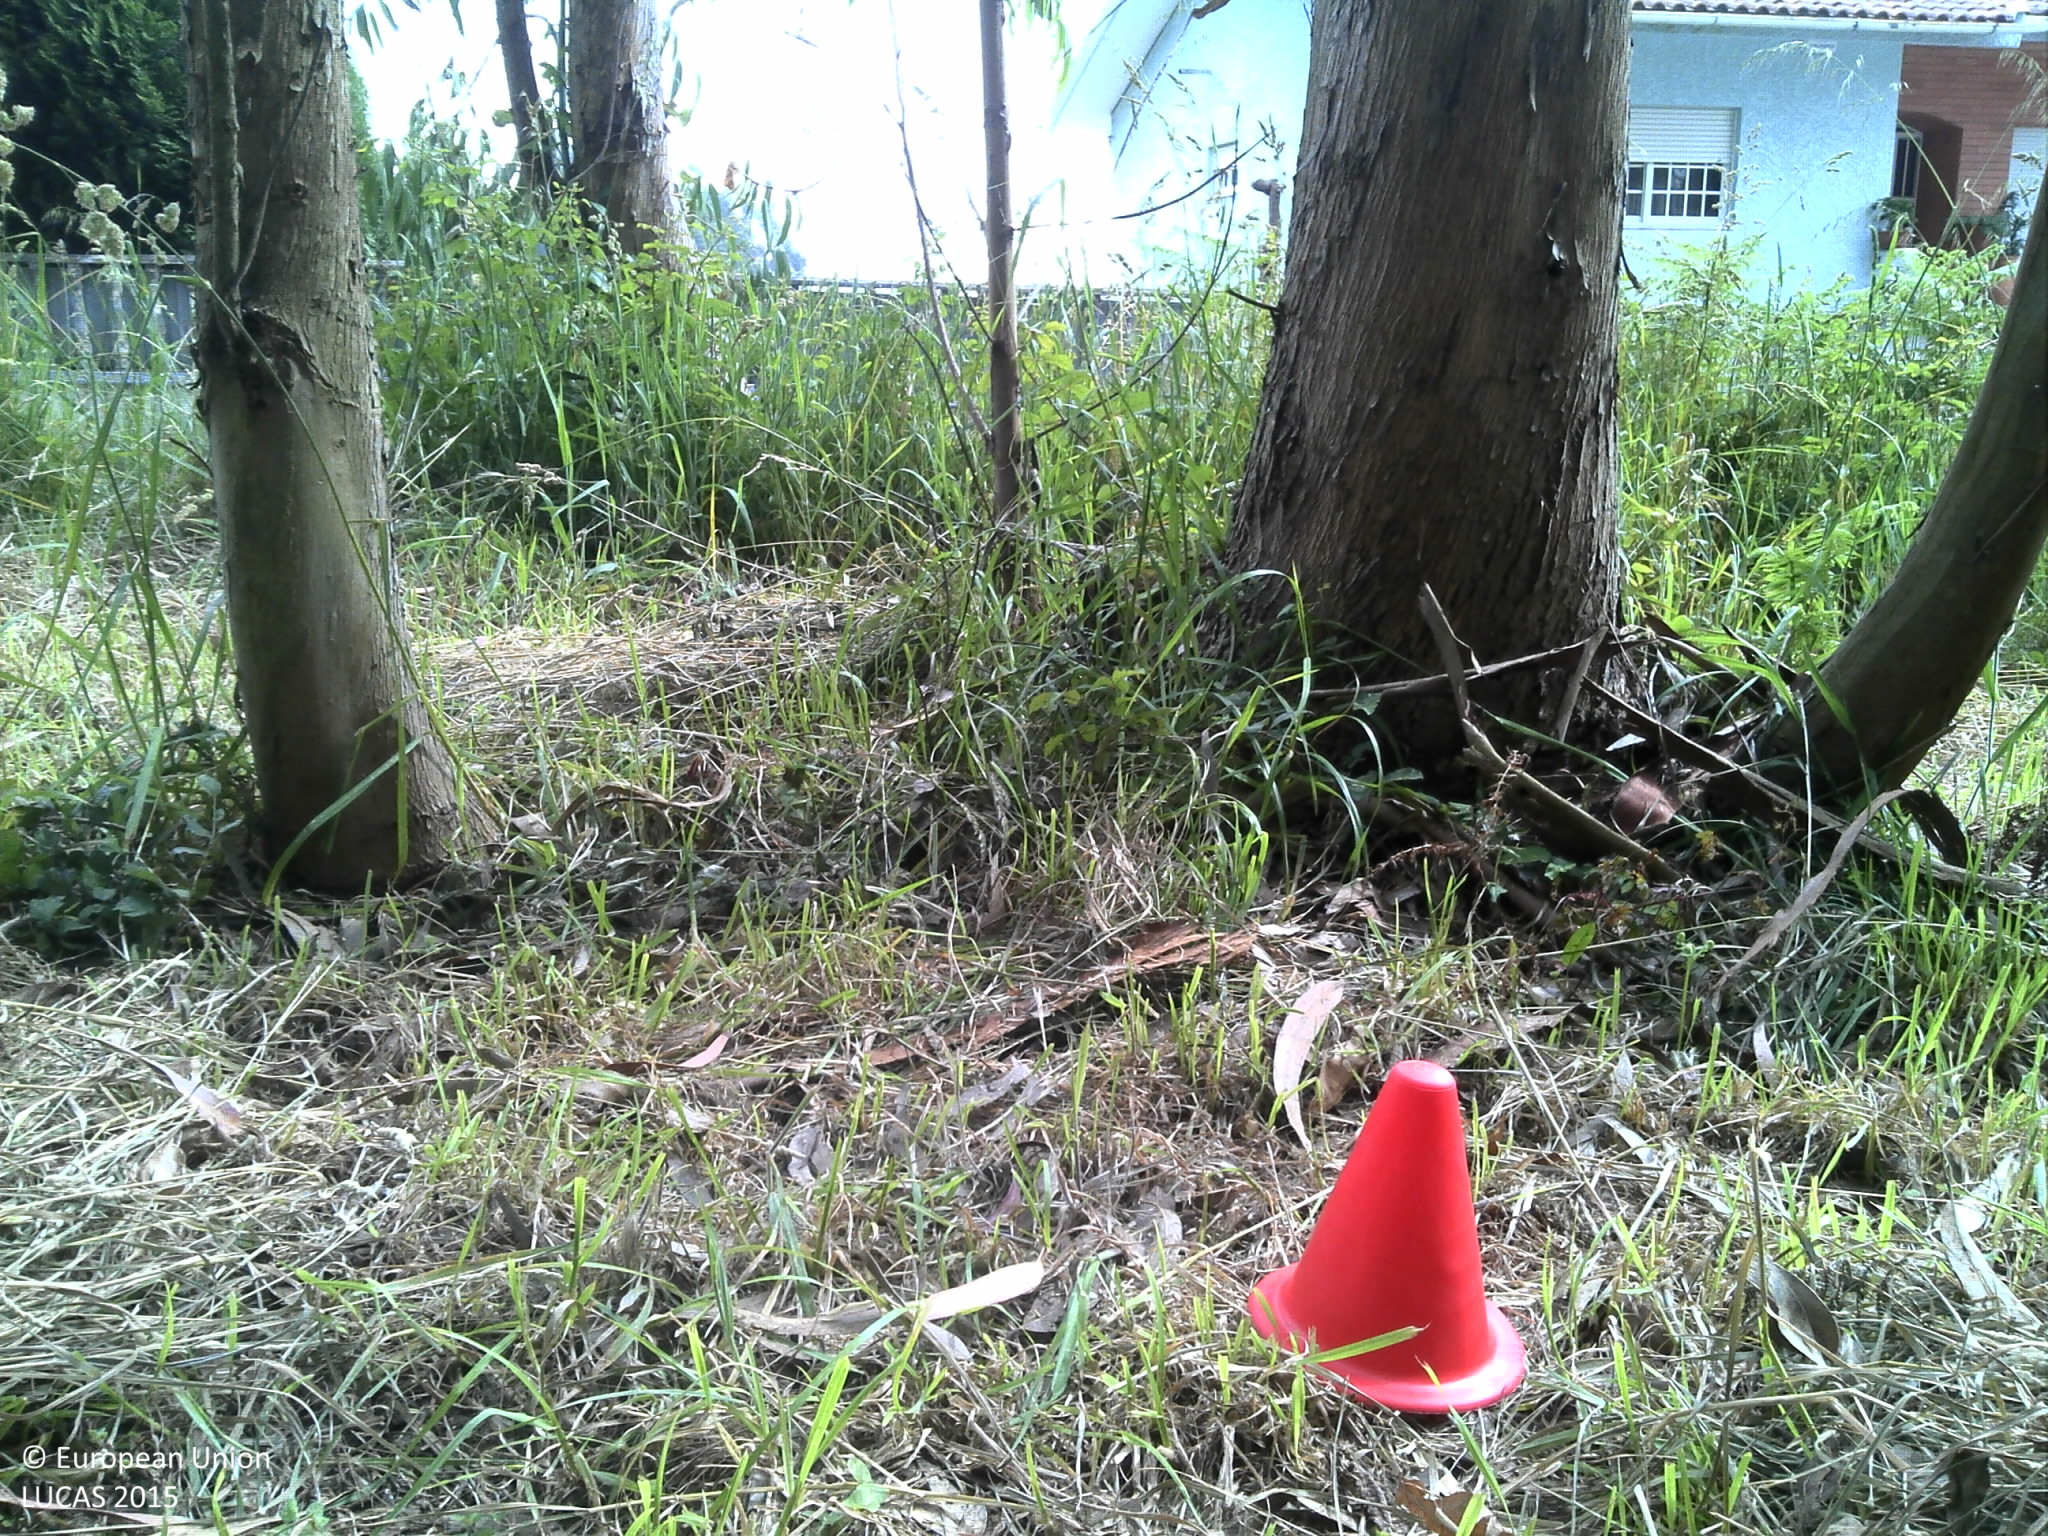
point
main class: Woodland
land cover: Broadleaved woodland
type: exotic forest
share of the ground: 50 - 75 %
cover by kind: broadleaved forest trees 75 %, herbaceous plants 15 %, shrubs 10 %
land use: Forestry
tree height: > 5 m
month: May
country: PT
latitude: 40.8893
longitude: -8.5303
